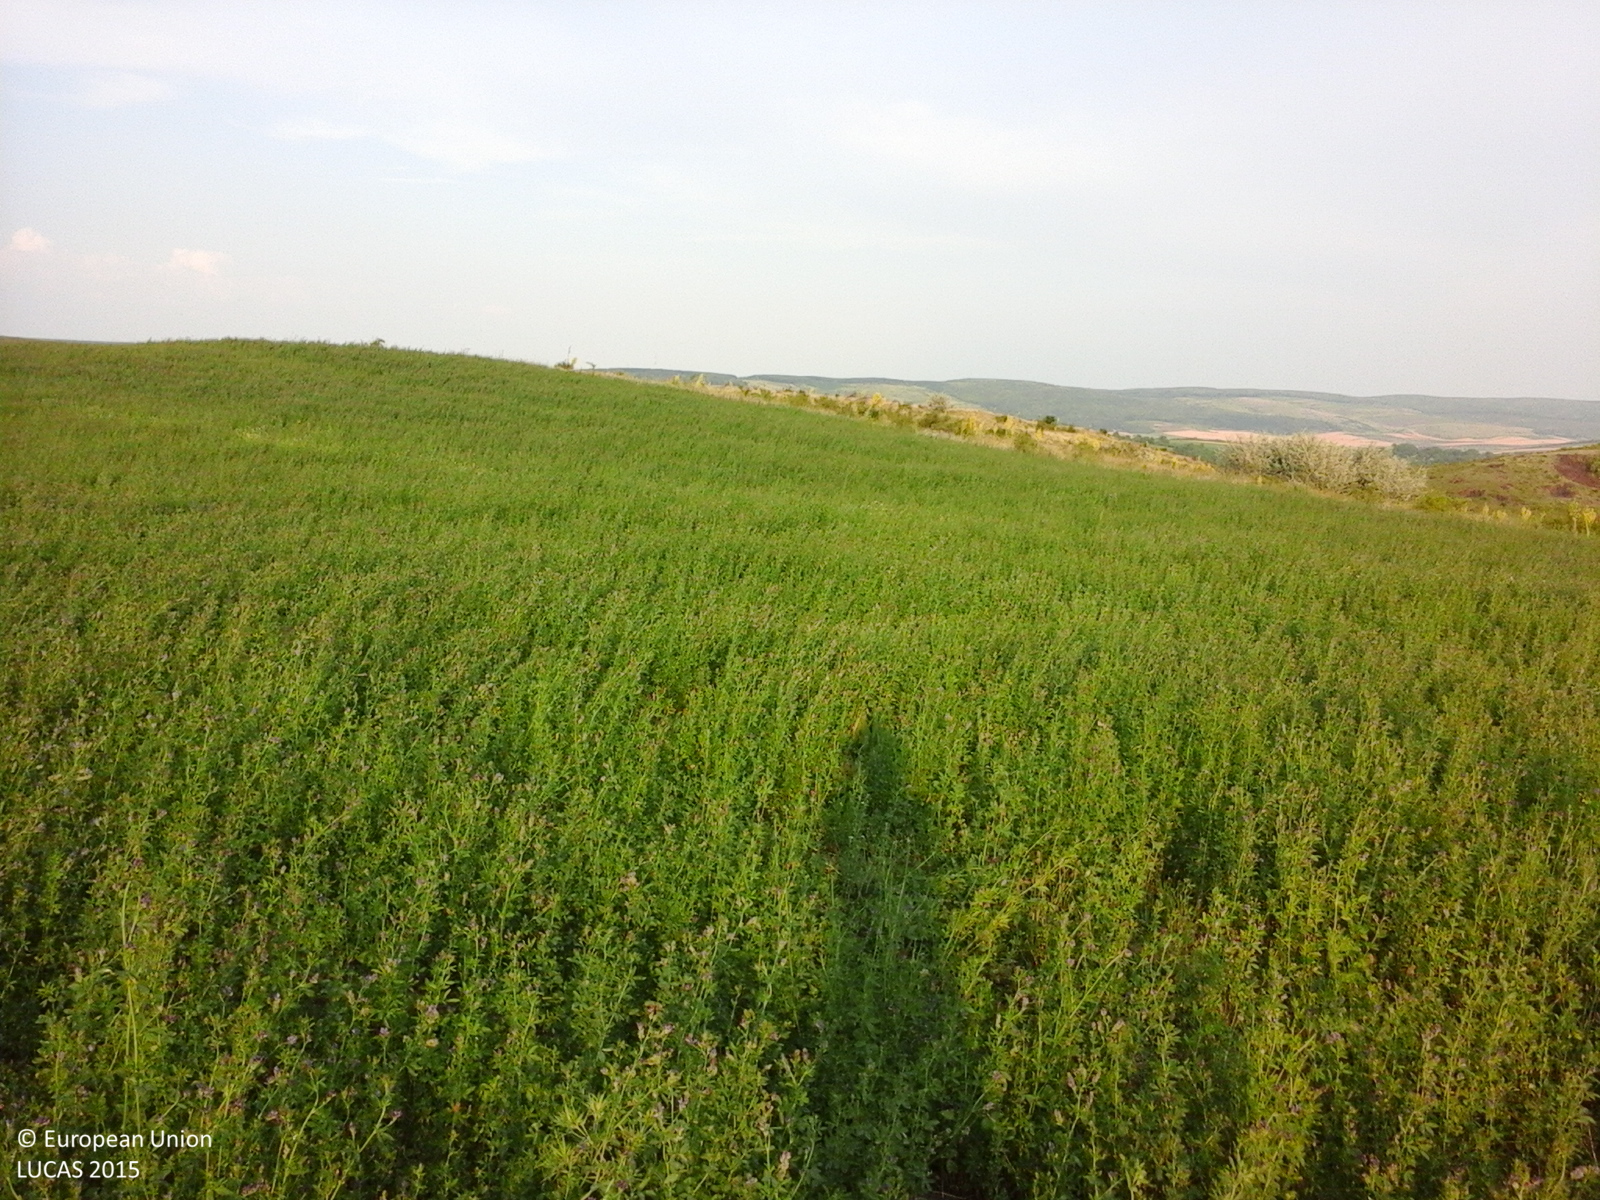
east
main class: Cropland
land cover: Lucerne
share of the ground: > 75 %
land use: Agriculture (excluding fallow land and kitchen gardens)
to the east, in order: Lucerne; Grassland with sparse tree/shrub cover; Fences; Spontaneously vegetated surfaces
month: June
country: RO
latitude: 46.5120
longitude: 27.4028
